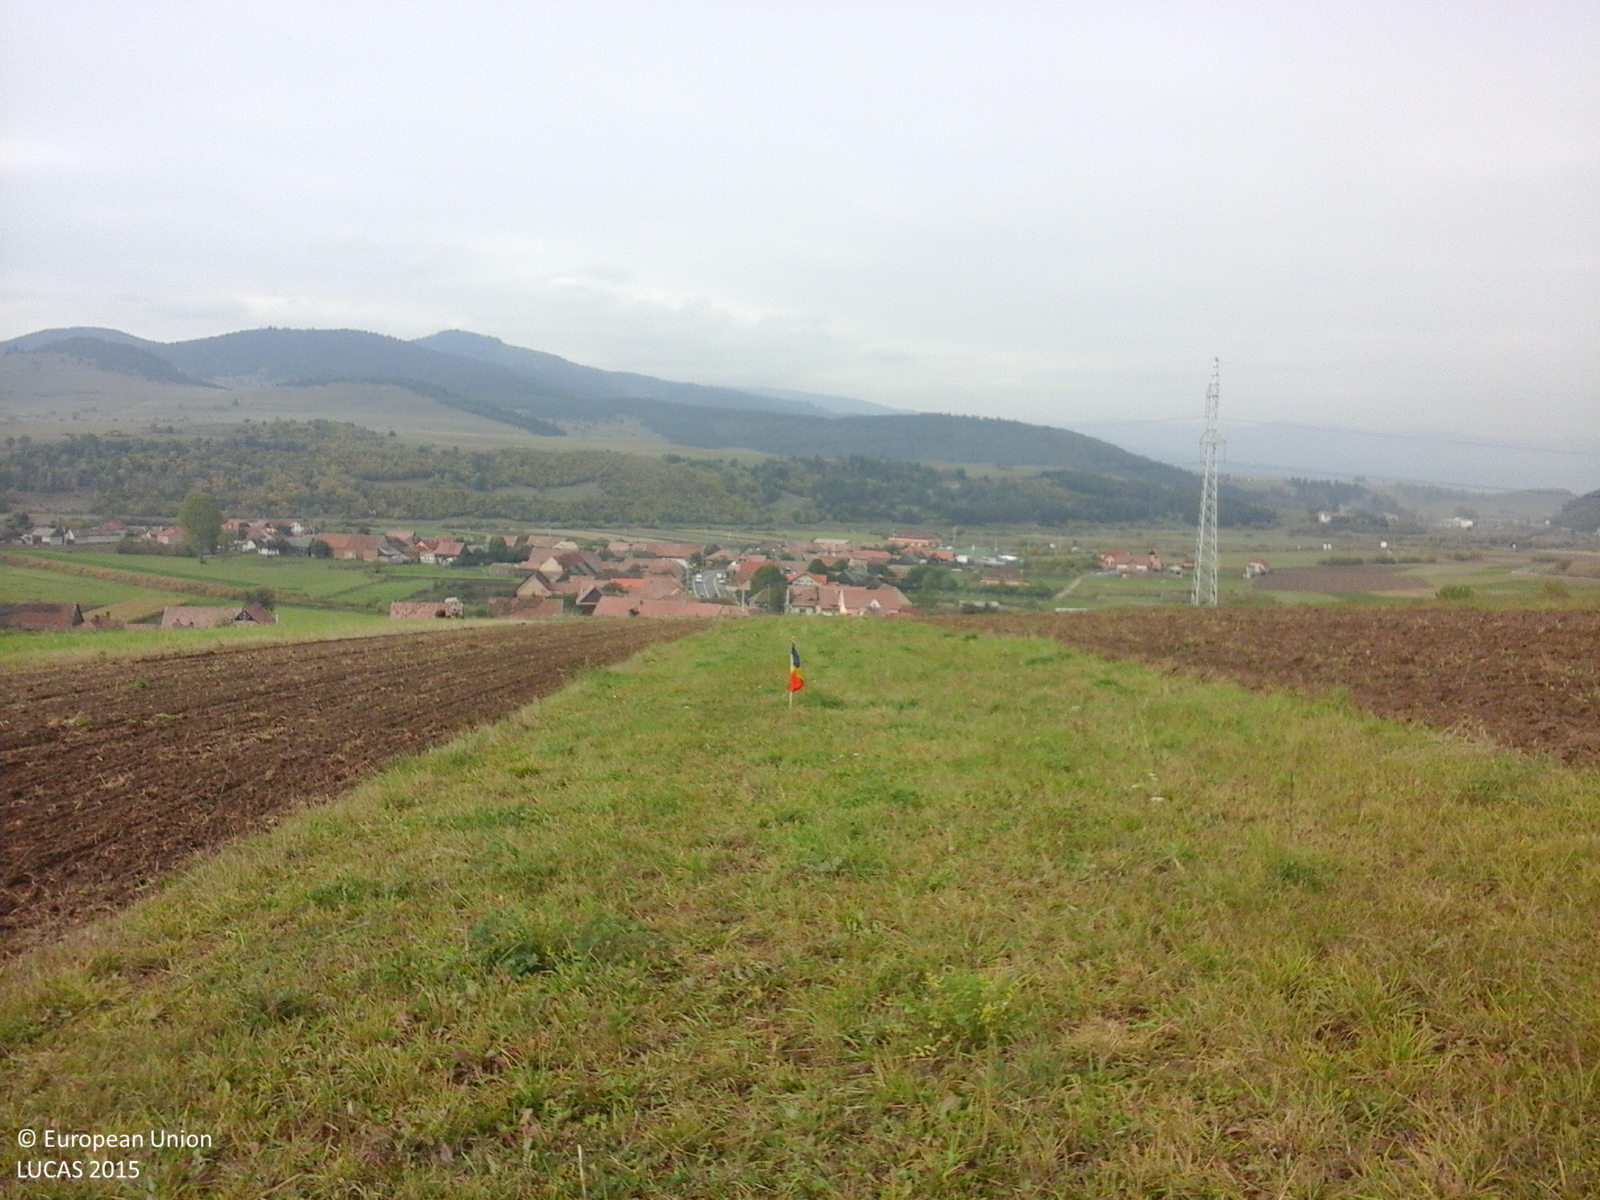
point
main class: Grassland
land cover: Grassland without tree/shrub cover
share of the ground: > 75 %
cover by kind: herbaceous plants 100 %
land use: Agriculture (excluding fallow land and kitchen gardens)
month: October
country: RO
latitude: 46.3165
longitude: 25.8425
